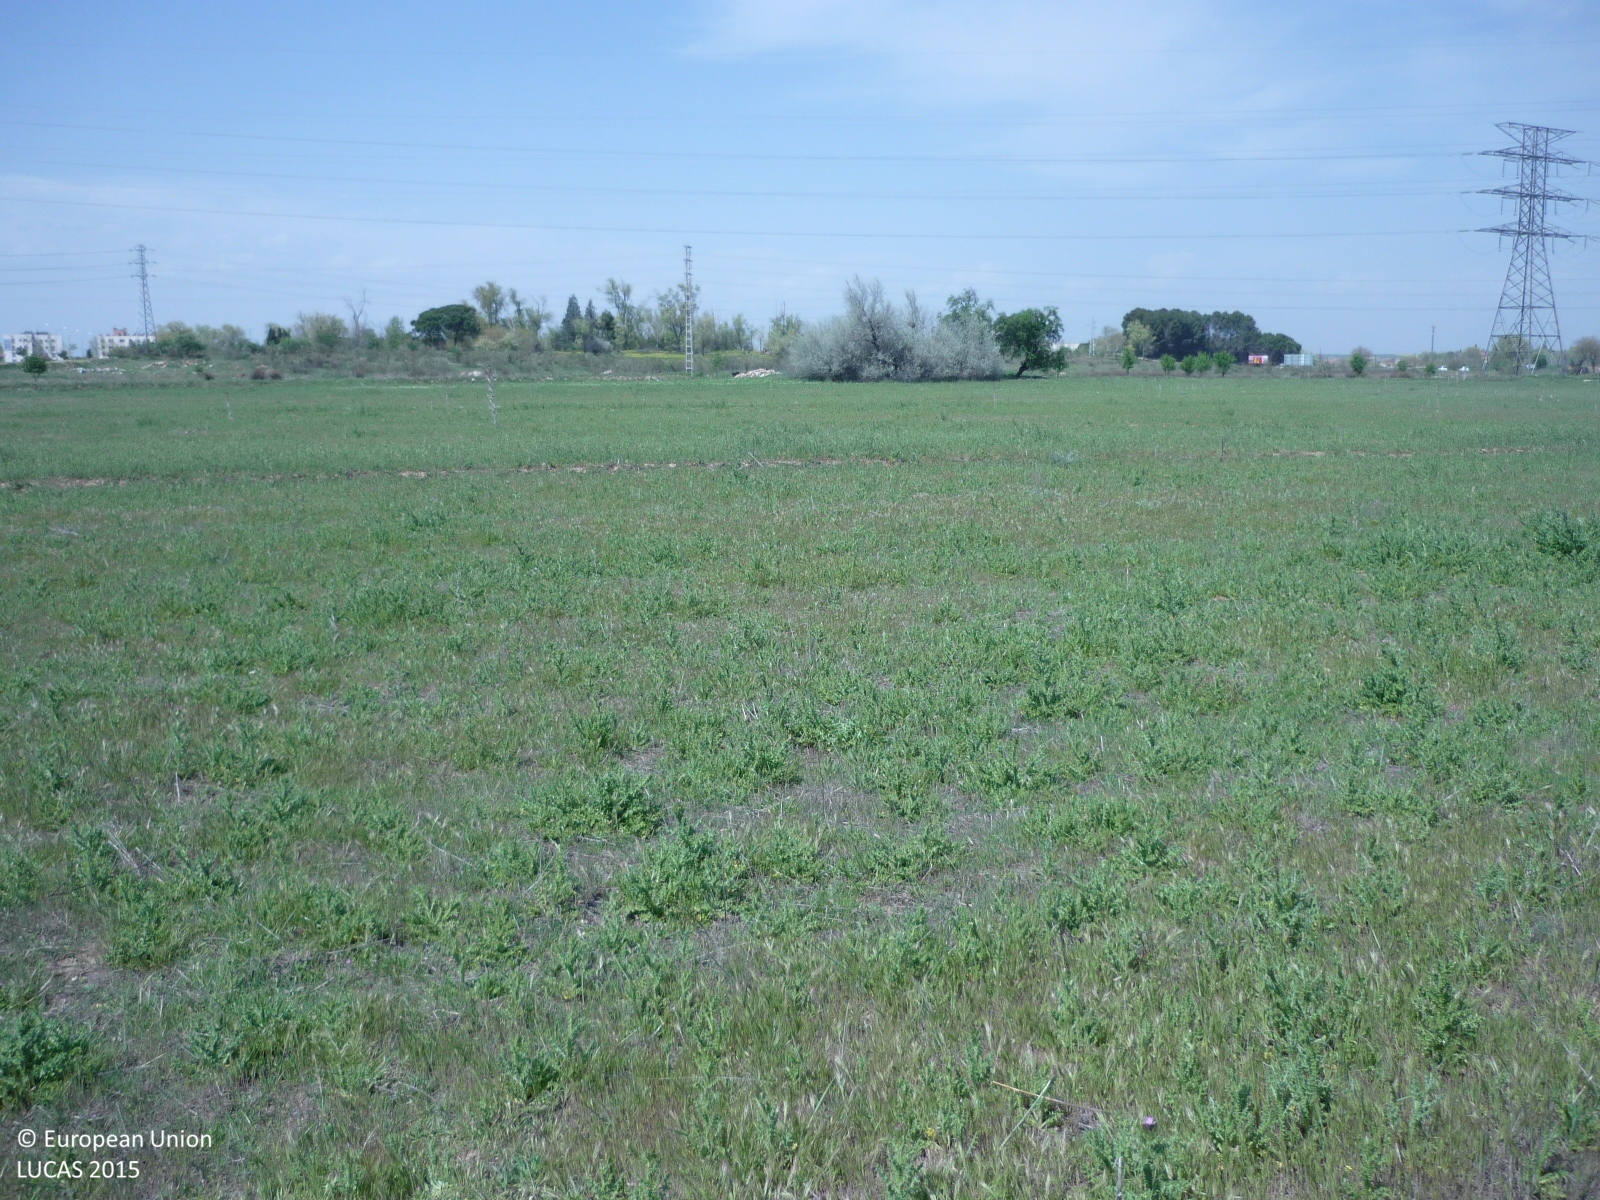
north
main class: Grassland
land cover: Spontaneously vegetated surfaces
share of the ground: > 75 %
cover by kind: herbaceous plants 90 %, consolidated bare surface 10 %
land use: Fallow land
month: April
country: ES
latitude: 40.4997
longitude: -3.3799
